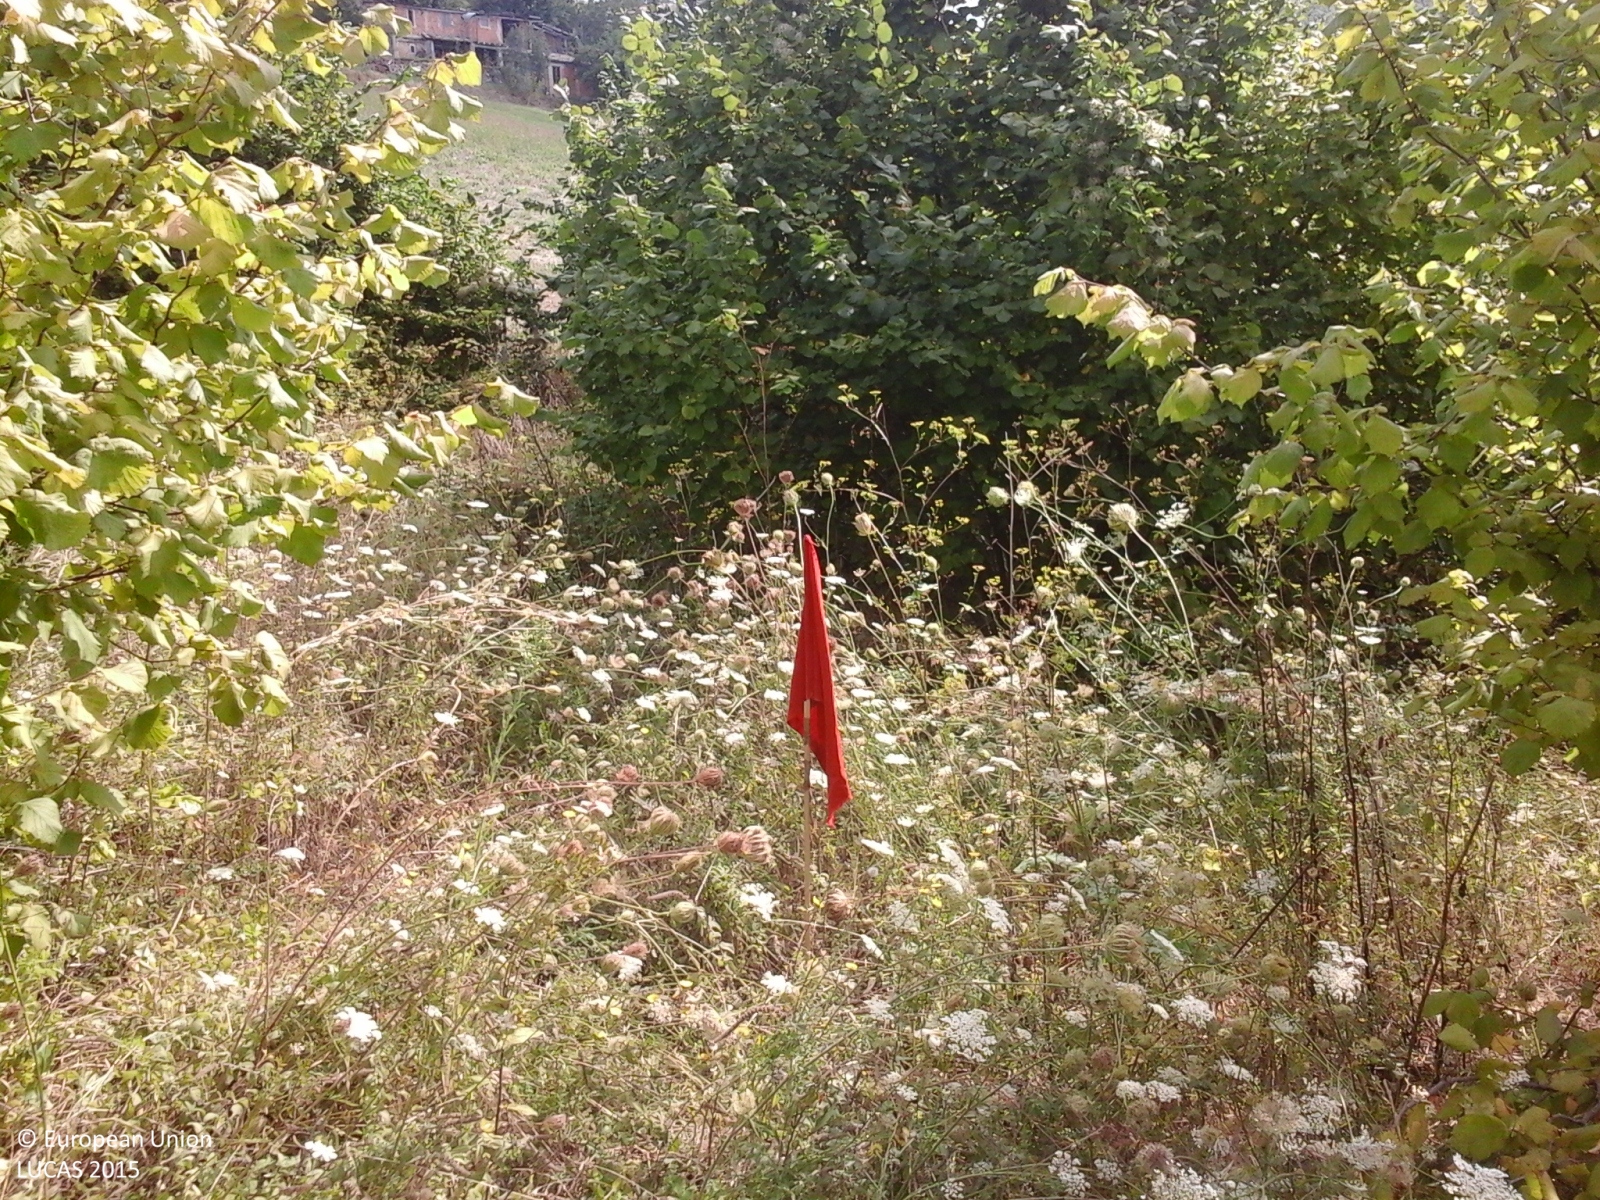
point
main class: Cropland
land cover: Nuts trees
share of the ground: > 75 %
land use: Agriculture (excluding fallow land and kitchen gardens)
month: August
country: IT
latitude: 43.3447
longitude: 13.1867
